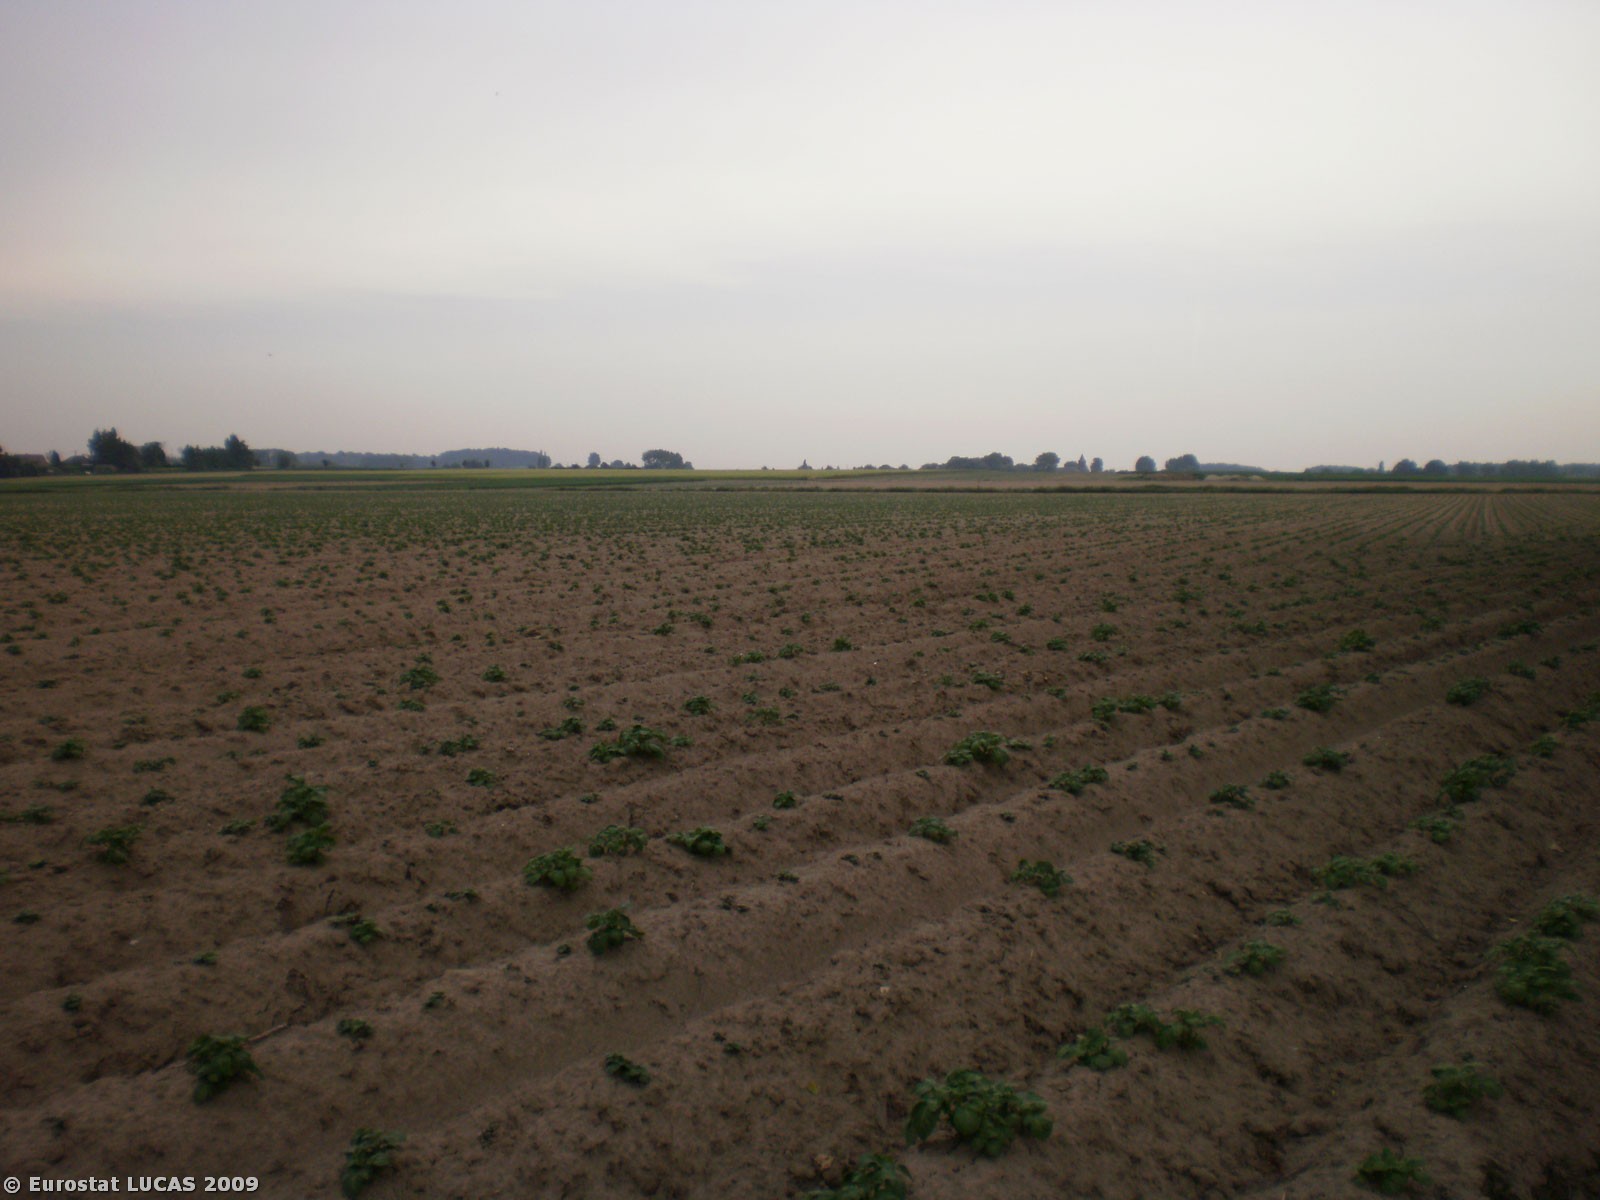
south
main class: Grassland
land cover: Grassland without tree/shrub cover
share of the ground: > 75 %
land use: Agriculture (excluding fallow land and kitchen gardens)
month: May
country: BE
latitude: 50.6653
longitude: 3.8108
